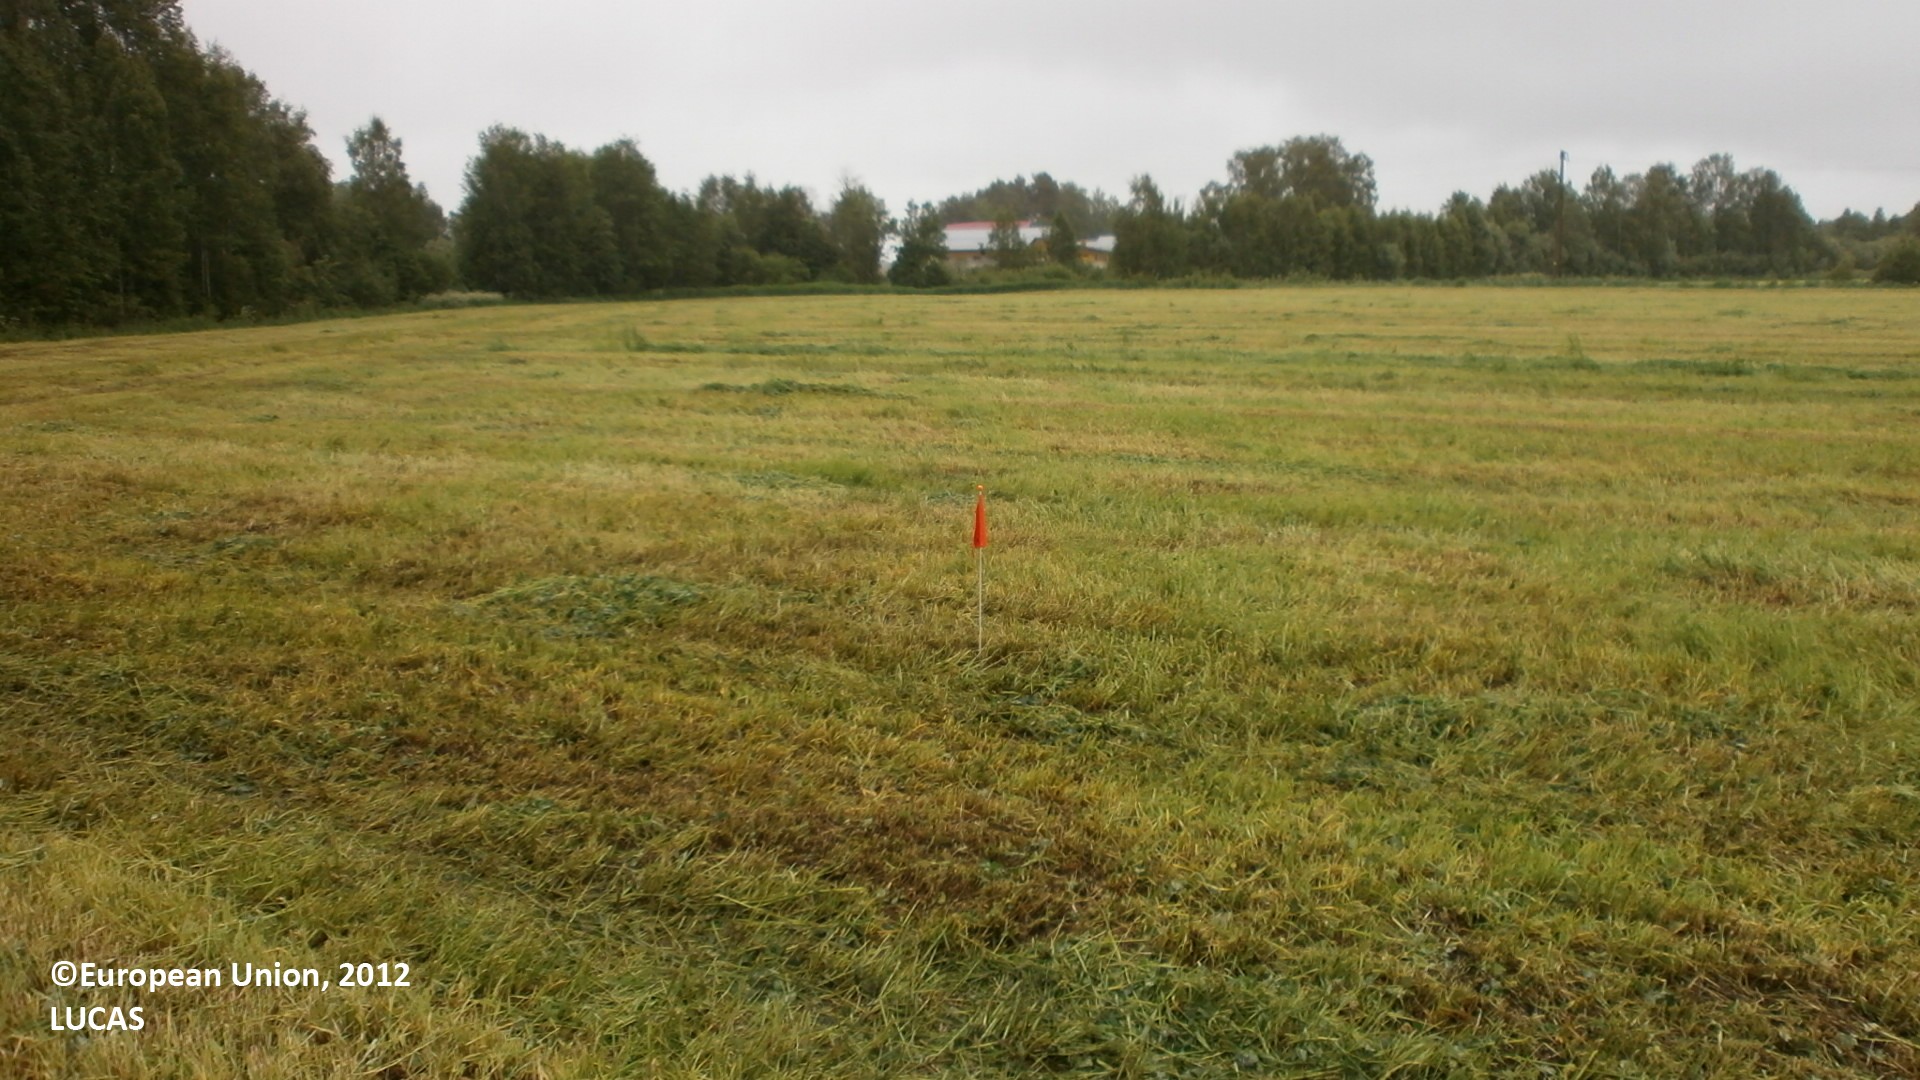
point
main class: Grassland
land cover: Grassland without tree/shrub cover
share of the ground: > 75 %
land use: Agriculture (excluding fallow land and kitchen gardens)
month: June
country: FI
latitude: 64.6281
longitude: 25.1190
